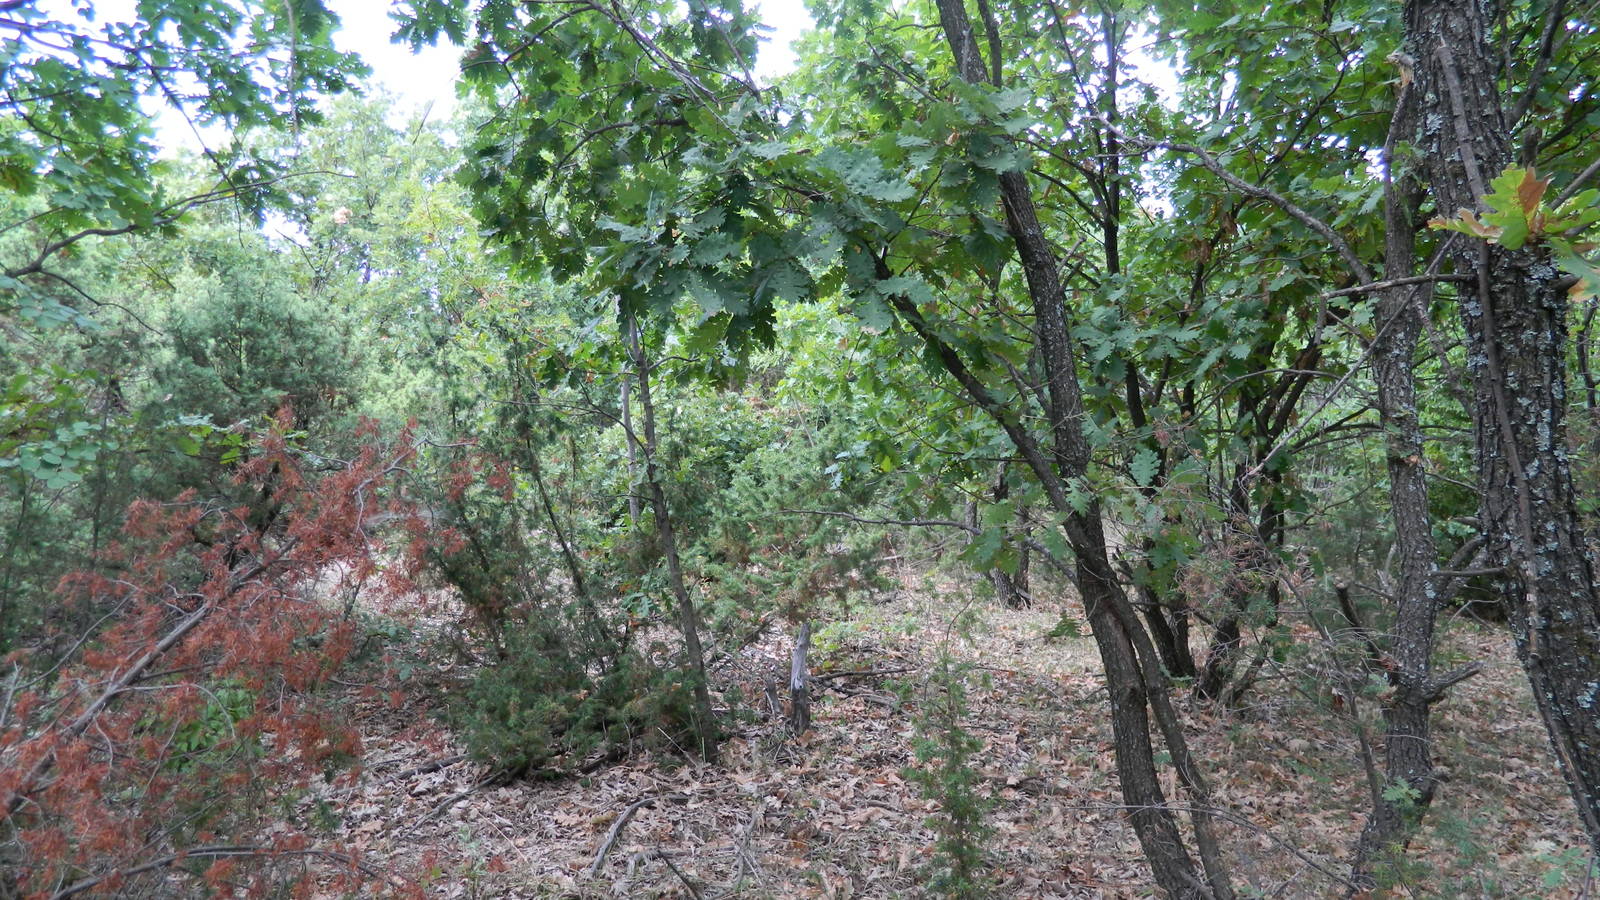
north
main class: Woodland
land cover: Broadleaved woodland
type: mesophytic deciduous forest
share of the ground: > 75 %
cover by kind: broadleaved forest trees 80 %, unconsolidated bare surface 15 %, shrubs 5 %
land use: Forestry
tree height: > 5 m
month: August
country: BG
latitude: 41.6956
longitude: 25.8192
